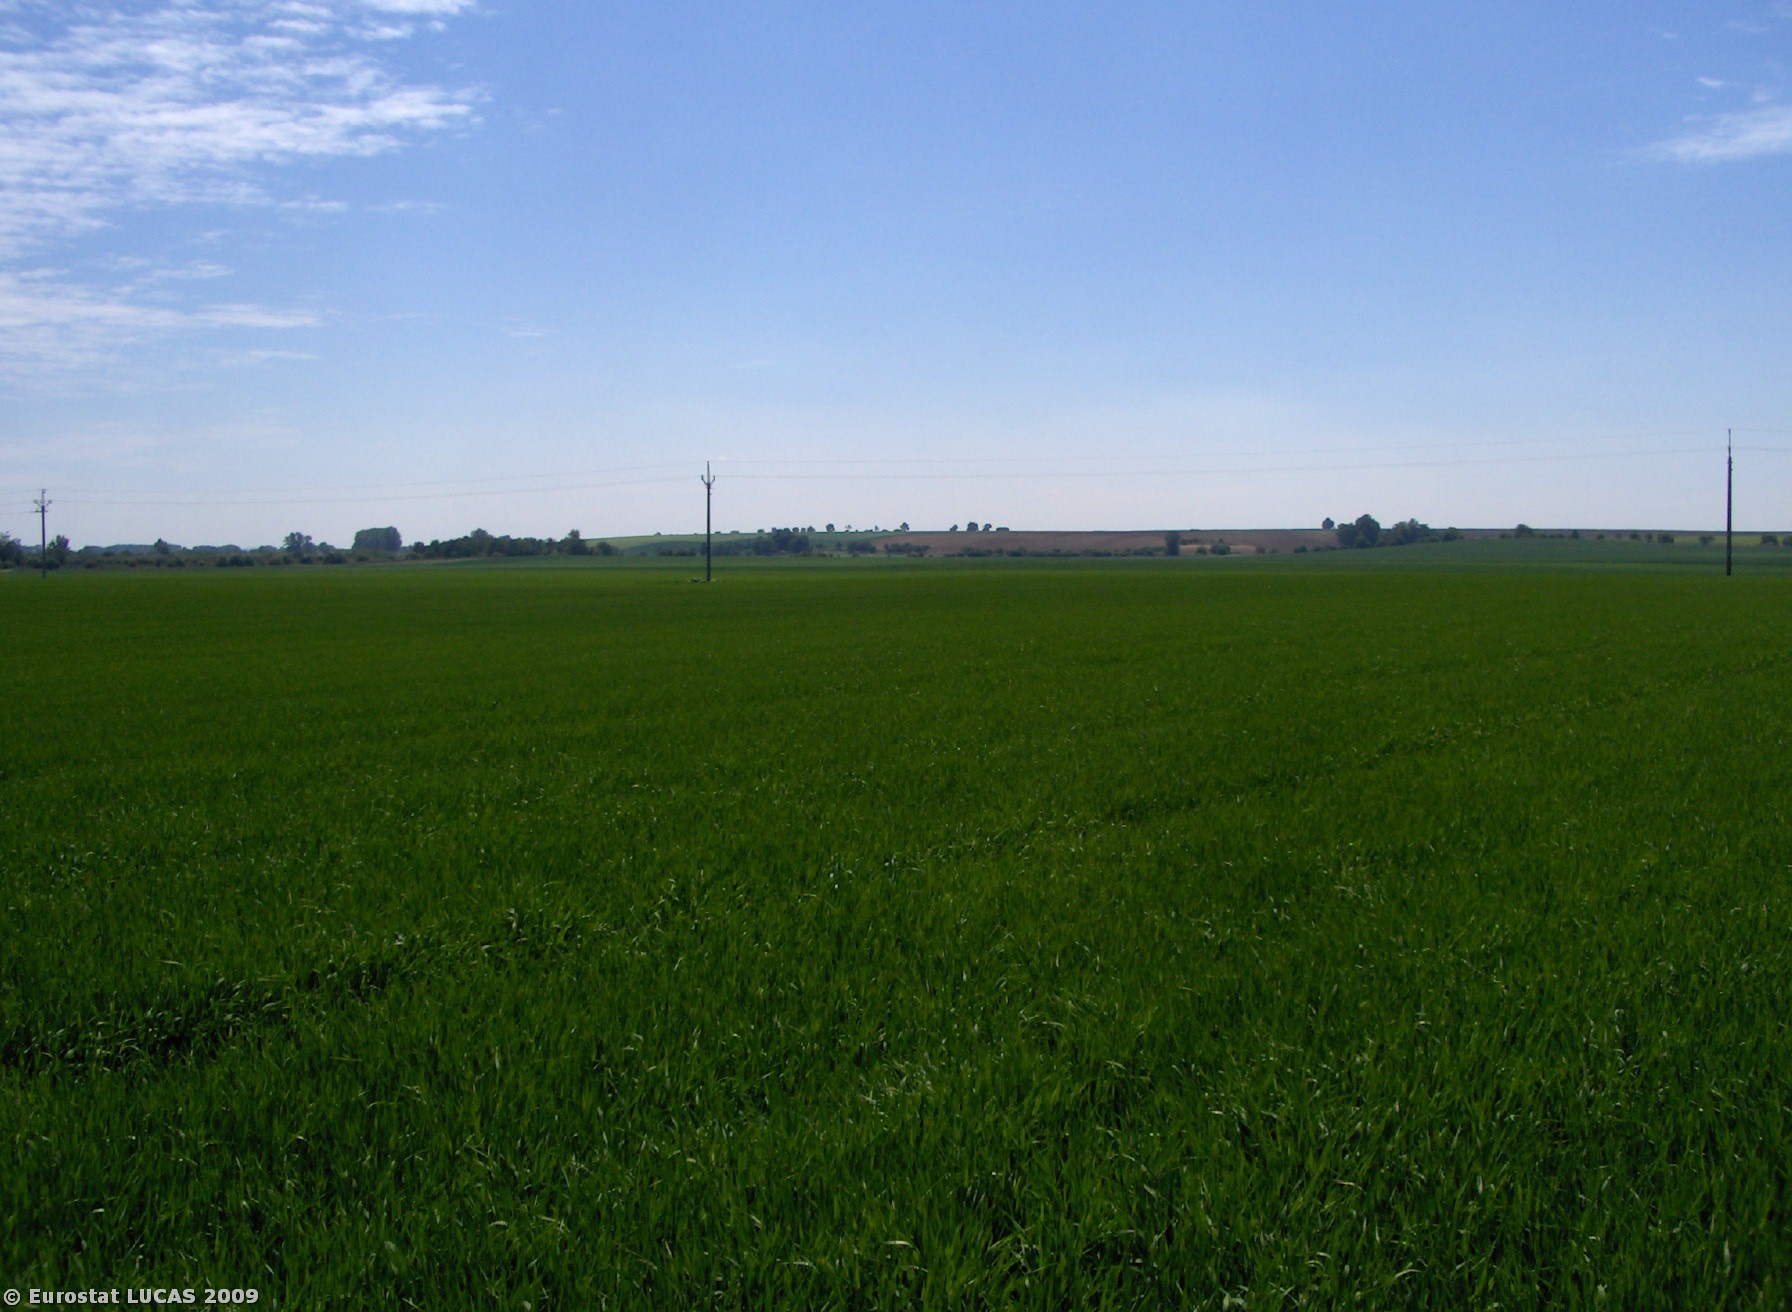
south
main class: Cropland
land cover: Barley
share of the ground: > 75 %
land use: Agriculture (excluding fallow land and kitchen gardens)
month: May
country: CZ
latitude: 49.3922
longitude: 17.2715
